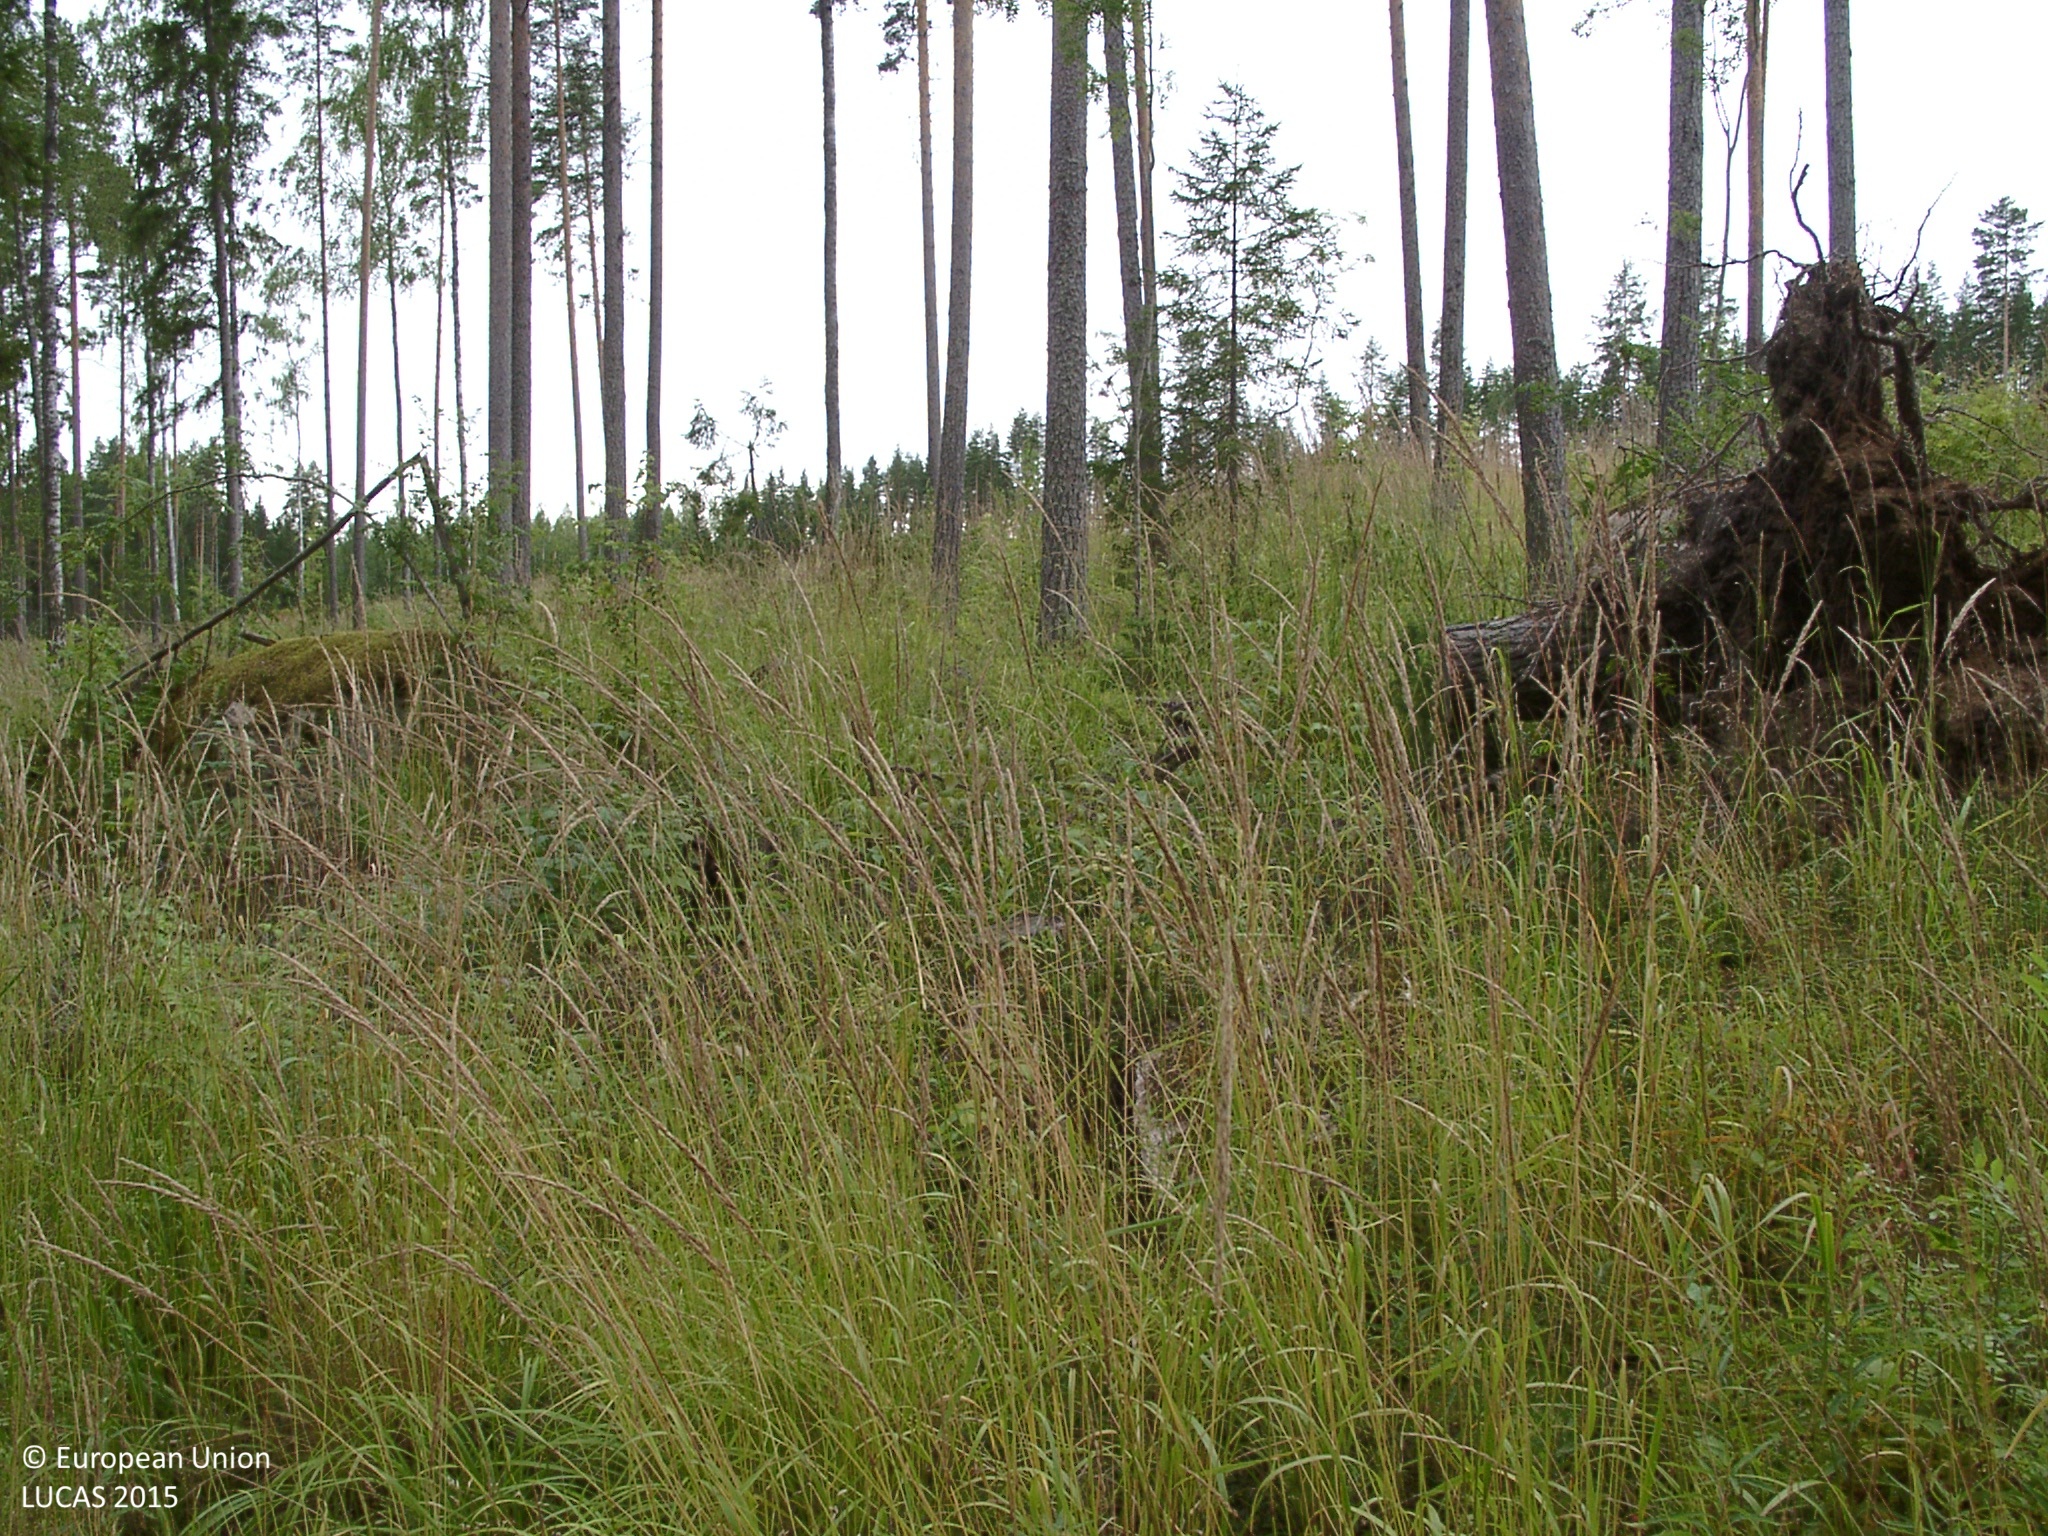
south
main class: Woodland
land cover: Other coniferous woodland
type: boreal forest
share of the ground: 50 - 75 %
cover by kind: coniferous forest trees 55 %, shrubs 15 %, broadleaved forest trees 10 %, herbaceous plants 10 %, lichens and mosses 10 %
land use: Forestry
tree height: > 5 m
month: August
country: FI
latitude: 61.7786
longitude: 25.3756
